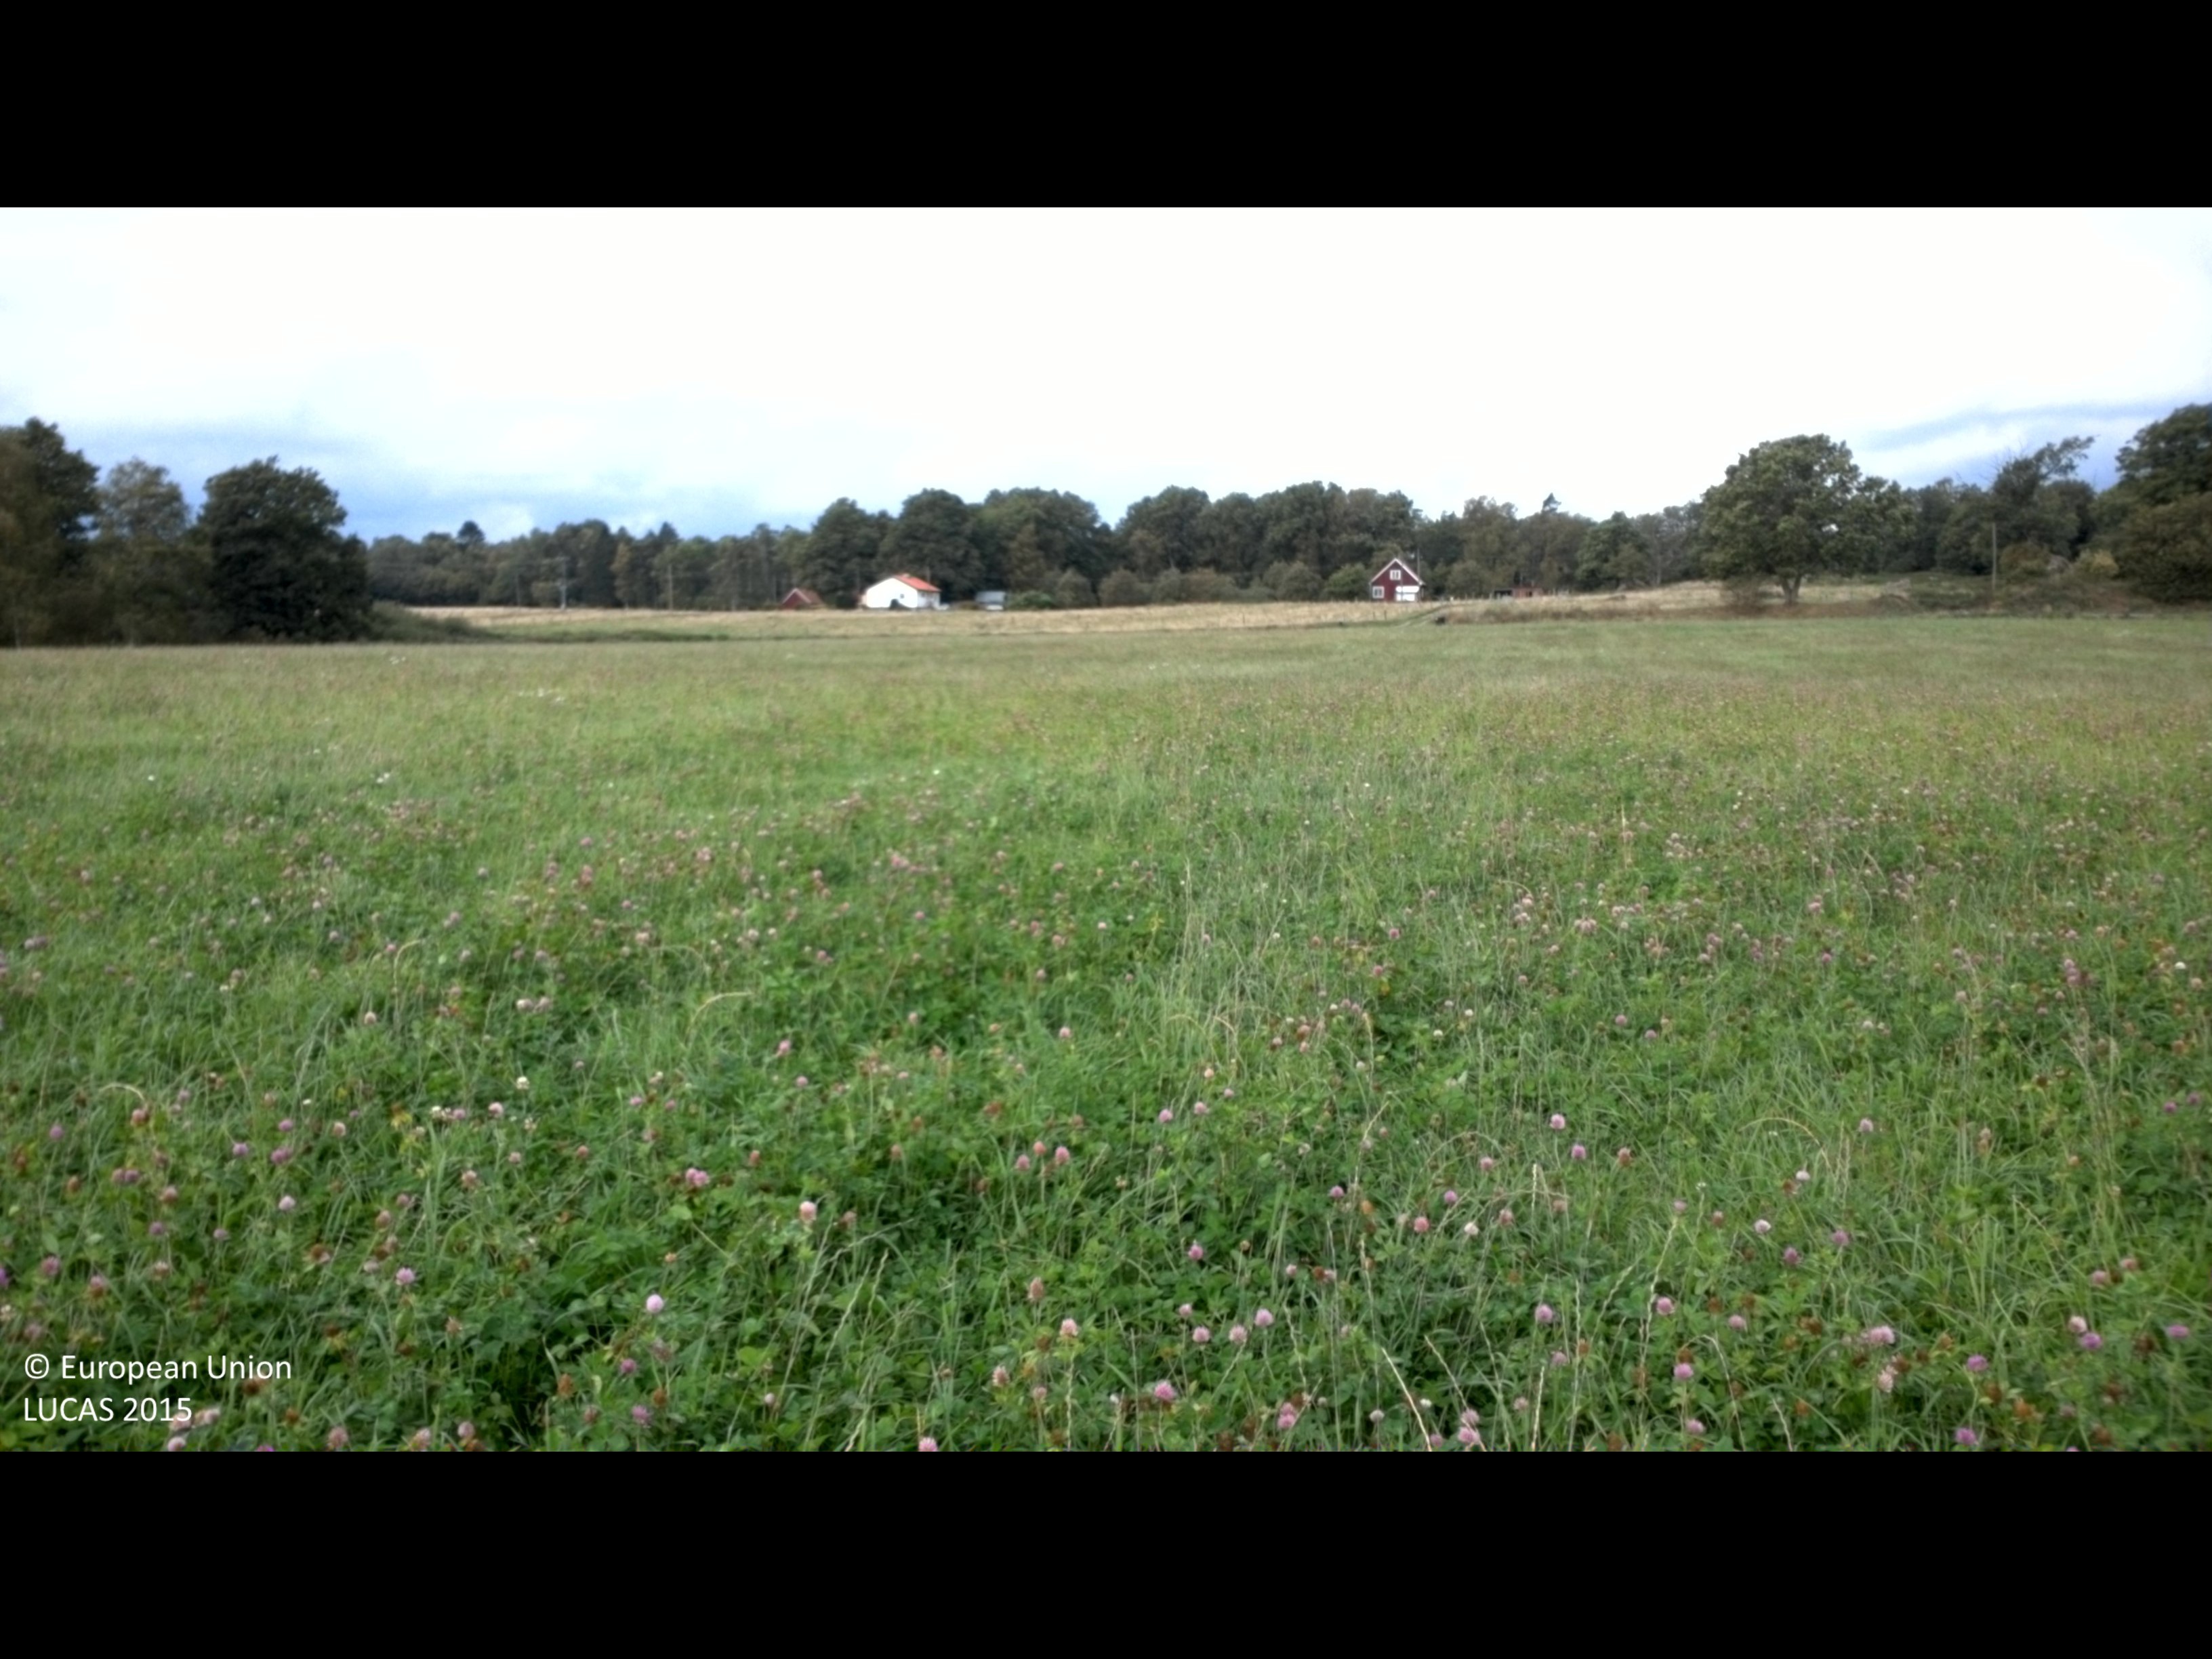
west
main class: Cropland
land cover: Clovers
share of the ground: > 75 %
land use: Agriculture (excluding fallow land and kitchen gardens)
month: September
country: SE
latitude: 56.2141
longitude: 14.0447
